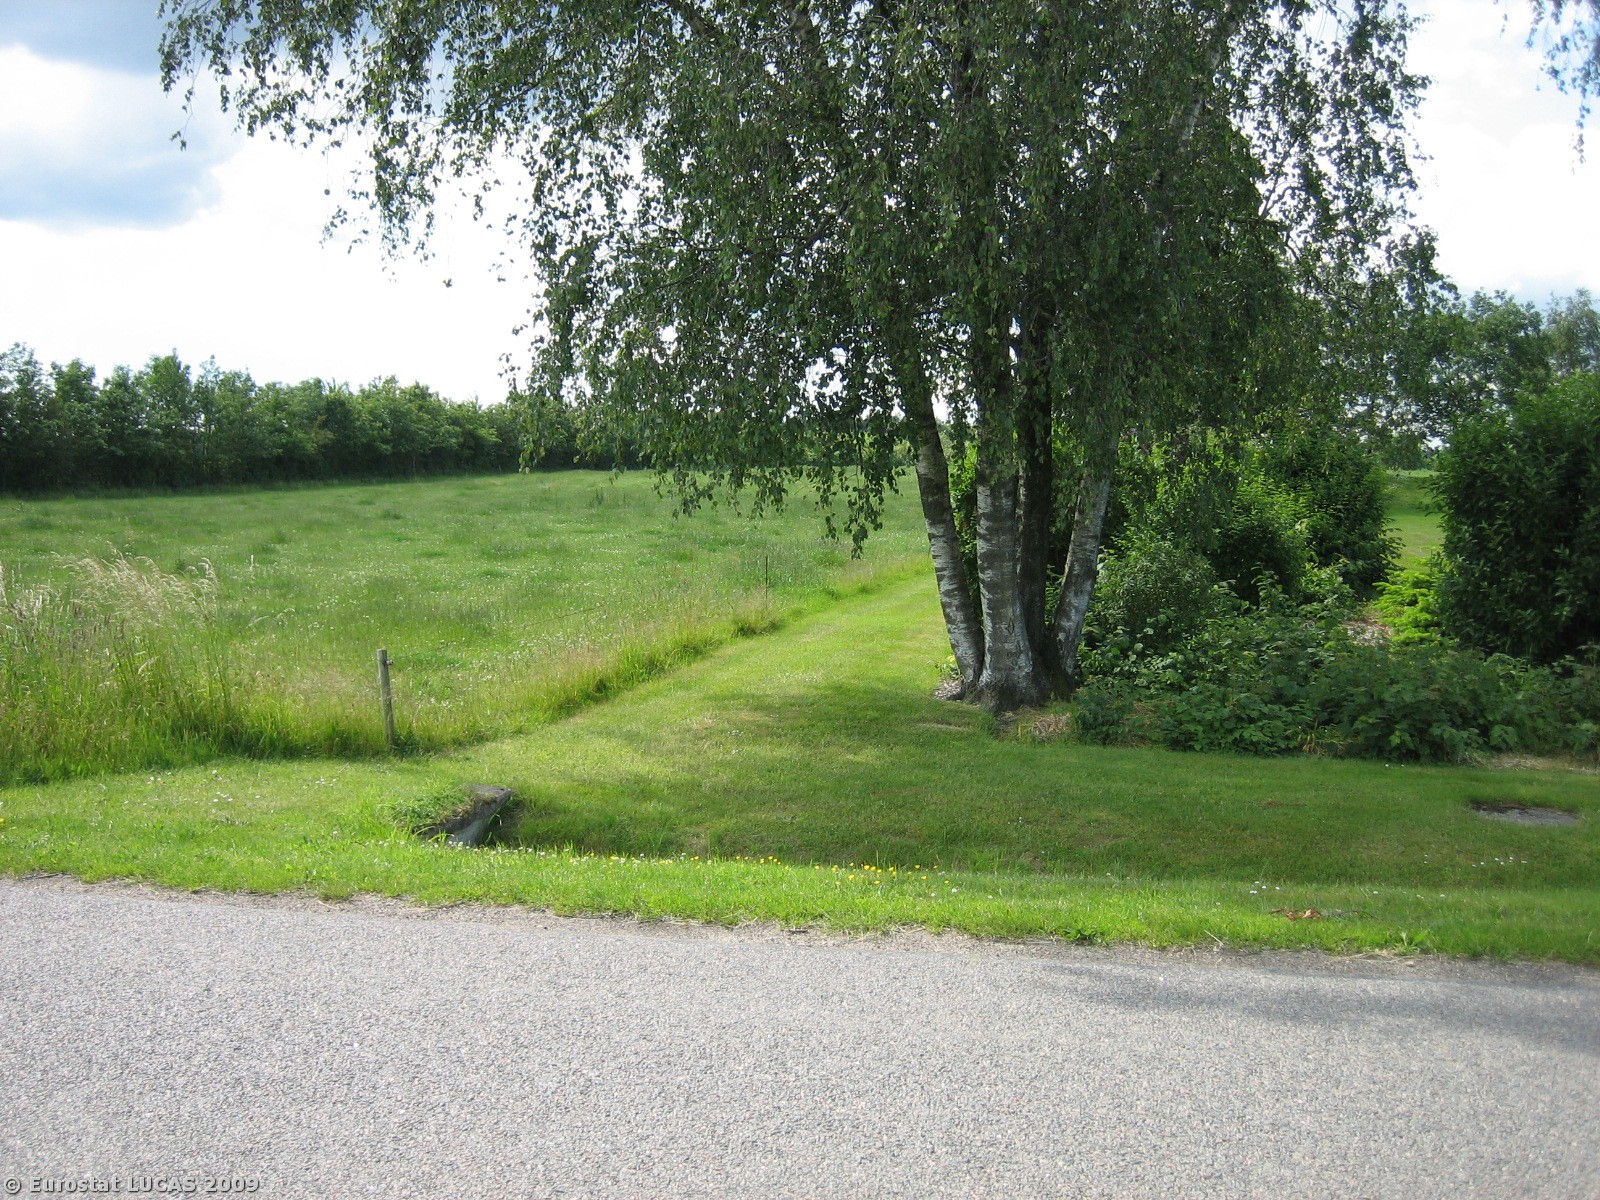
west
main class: Woodland
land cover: Broadleaved woodland
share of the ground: > 75 %
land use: Forestry
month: June
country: DK
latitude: 55.5381
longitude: 9.1926
